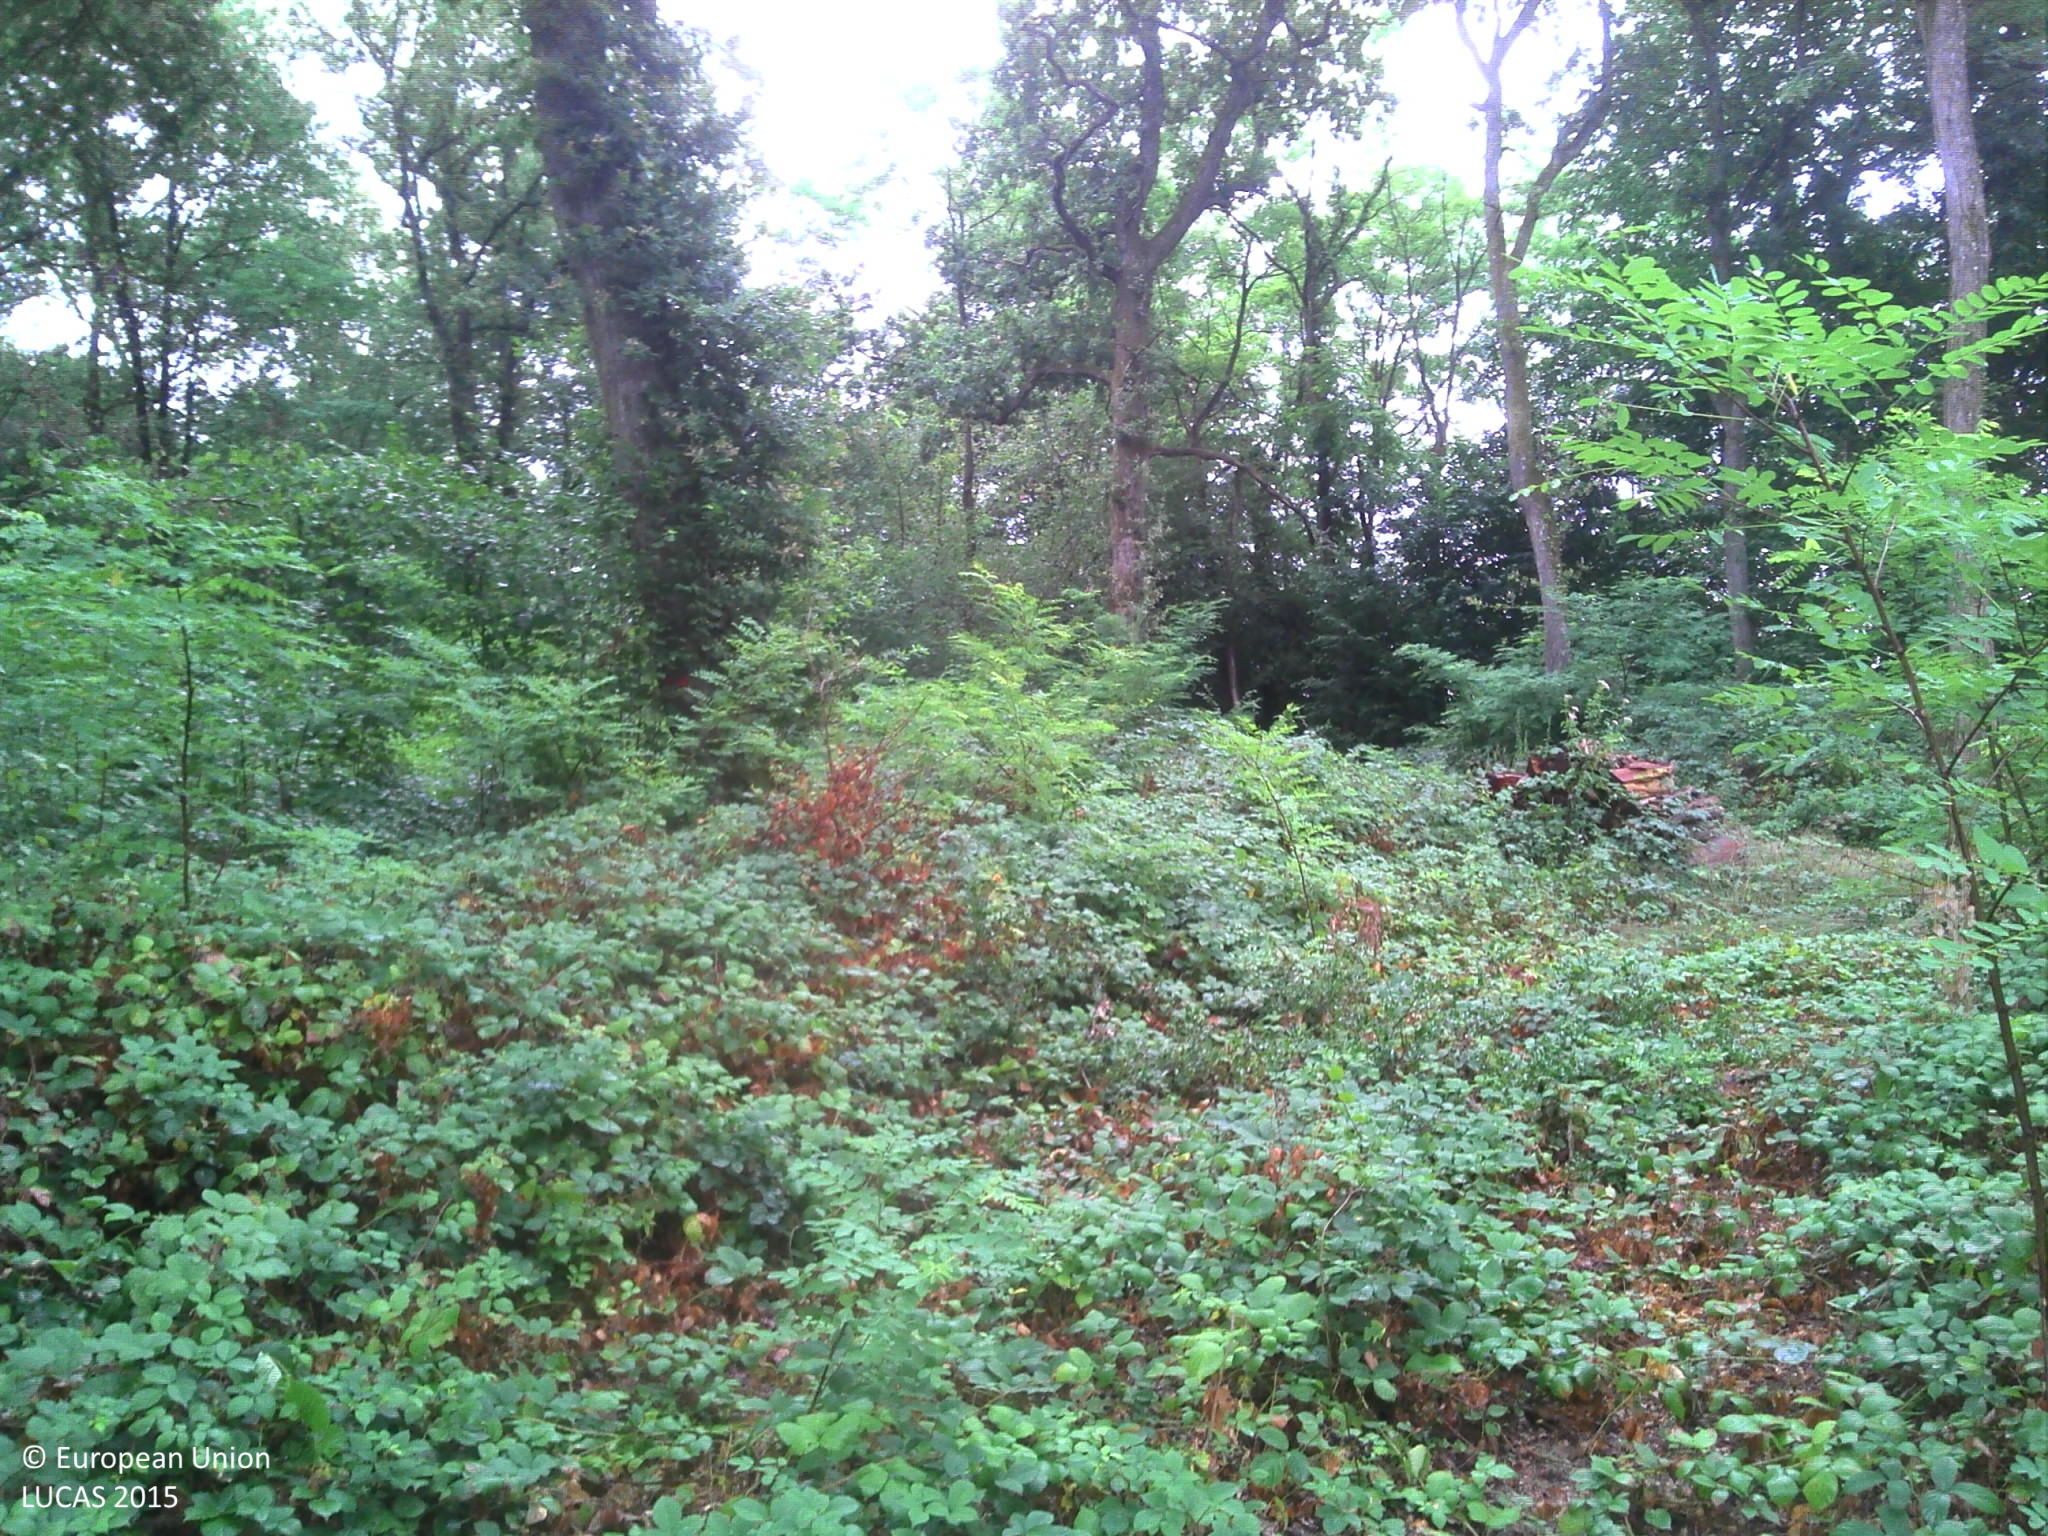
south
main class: Woodland
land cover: Broadleaved woodland
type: mesophytic deciduous forest
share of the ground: > 75 %
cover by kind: broadleaved forest trees 75 %, herbaceous plants 25 %
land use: Forestry
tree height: > 5 m
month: July
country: FR
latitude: 46.6899
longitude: 5.0984
